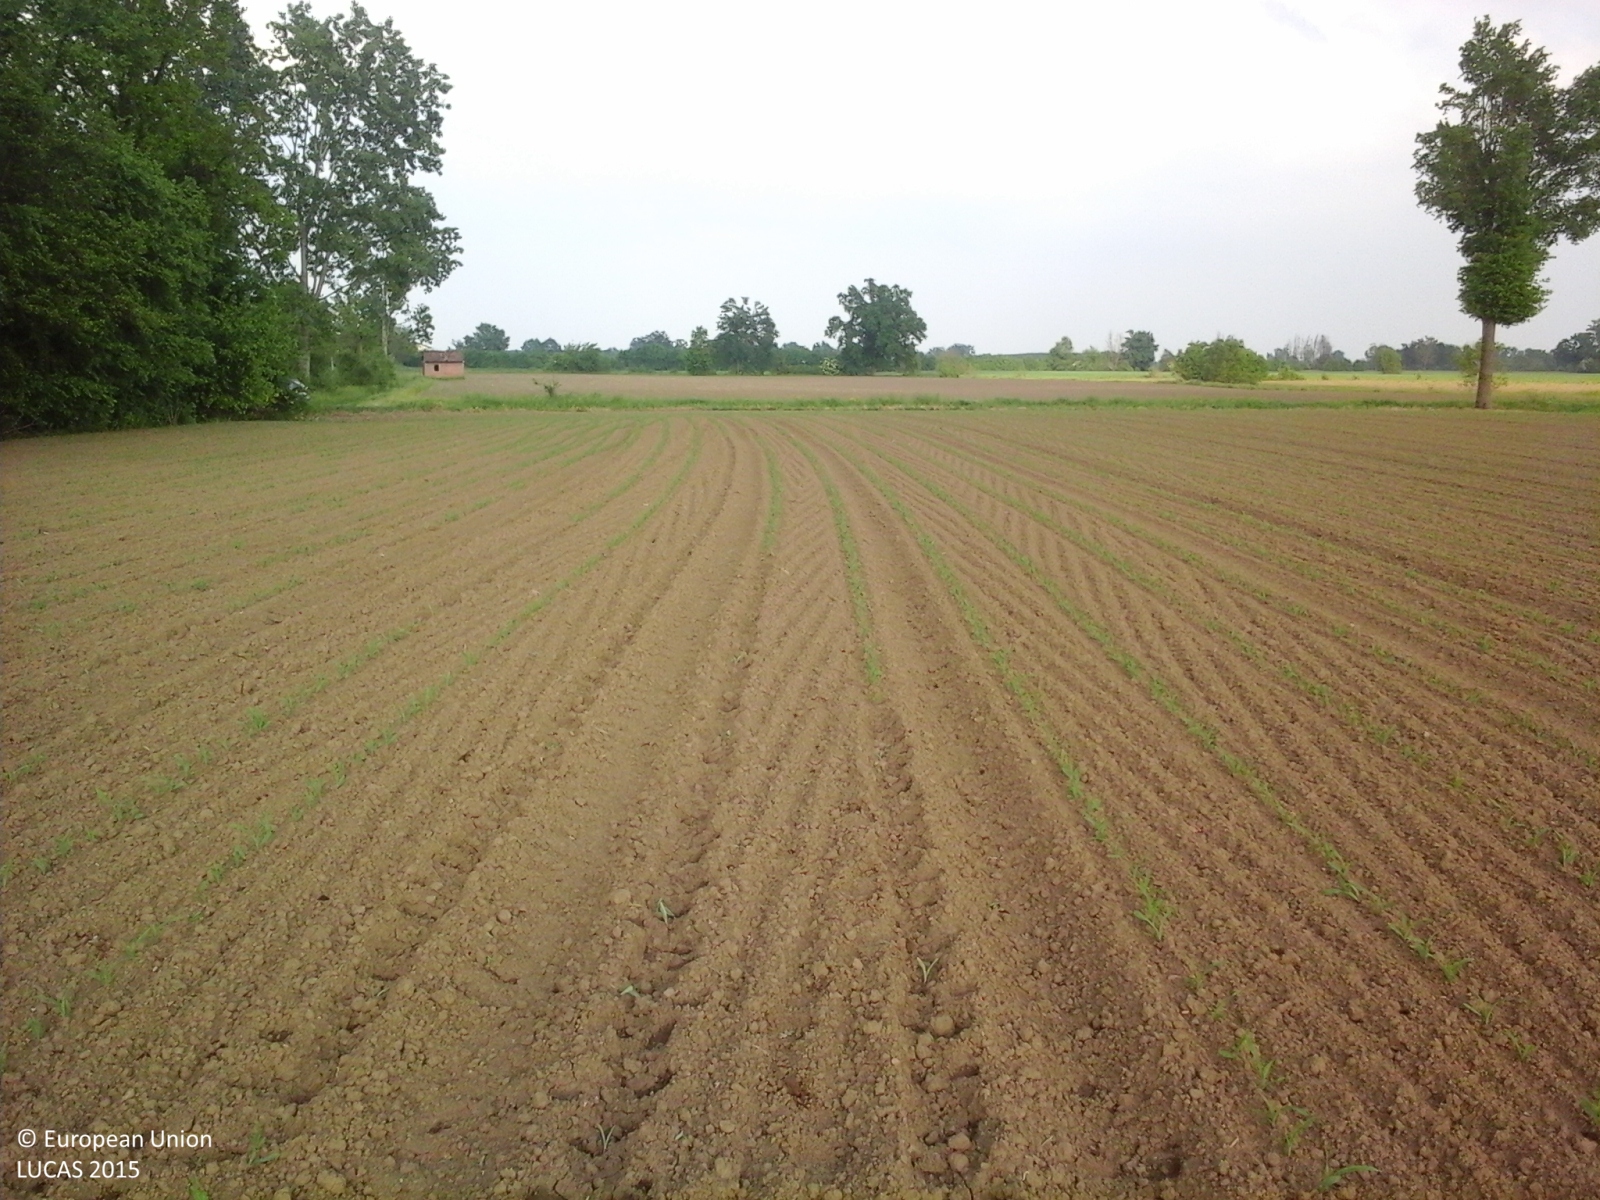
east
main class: Cropland
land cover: Maize
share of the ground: < 10 %
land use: Agriculture (excluding fallow land and kitchen gardens)
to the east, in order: Maize; Ditches and canals; Grass margins; Tracks; Grass margins; Ditches and canals; Soya
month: May
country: IT
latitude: 45.0350
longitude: 10.3927
